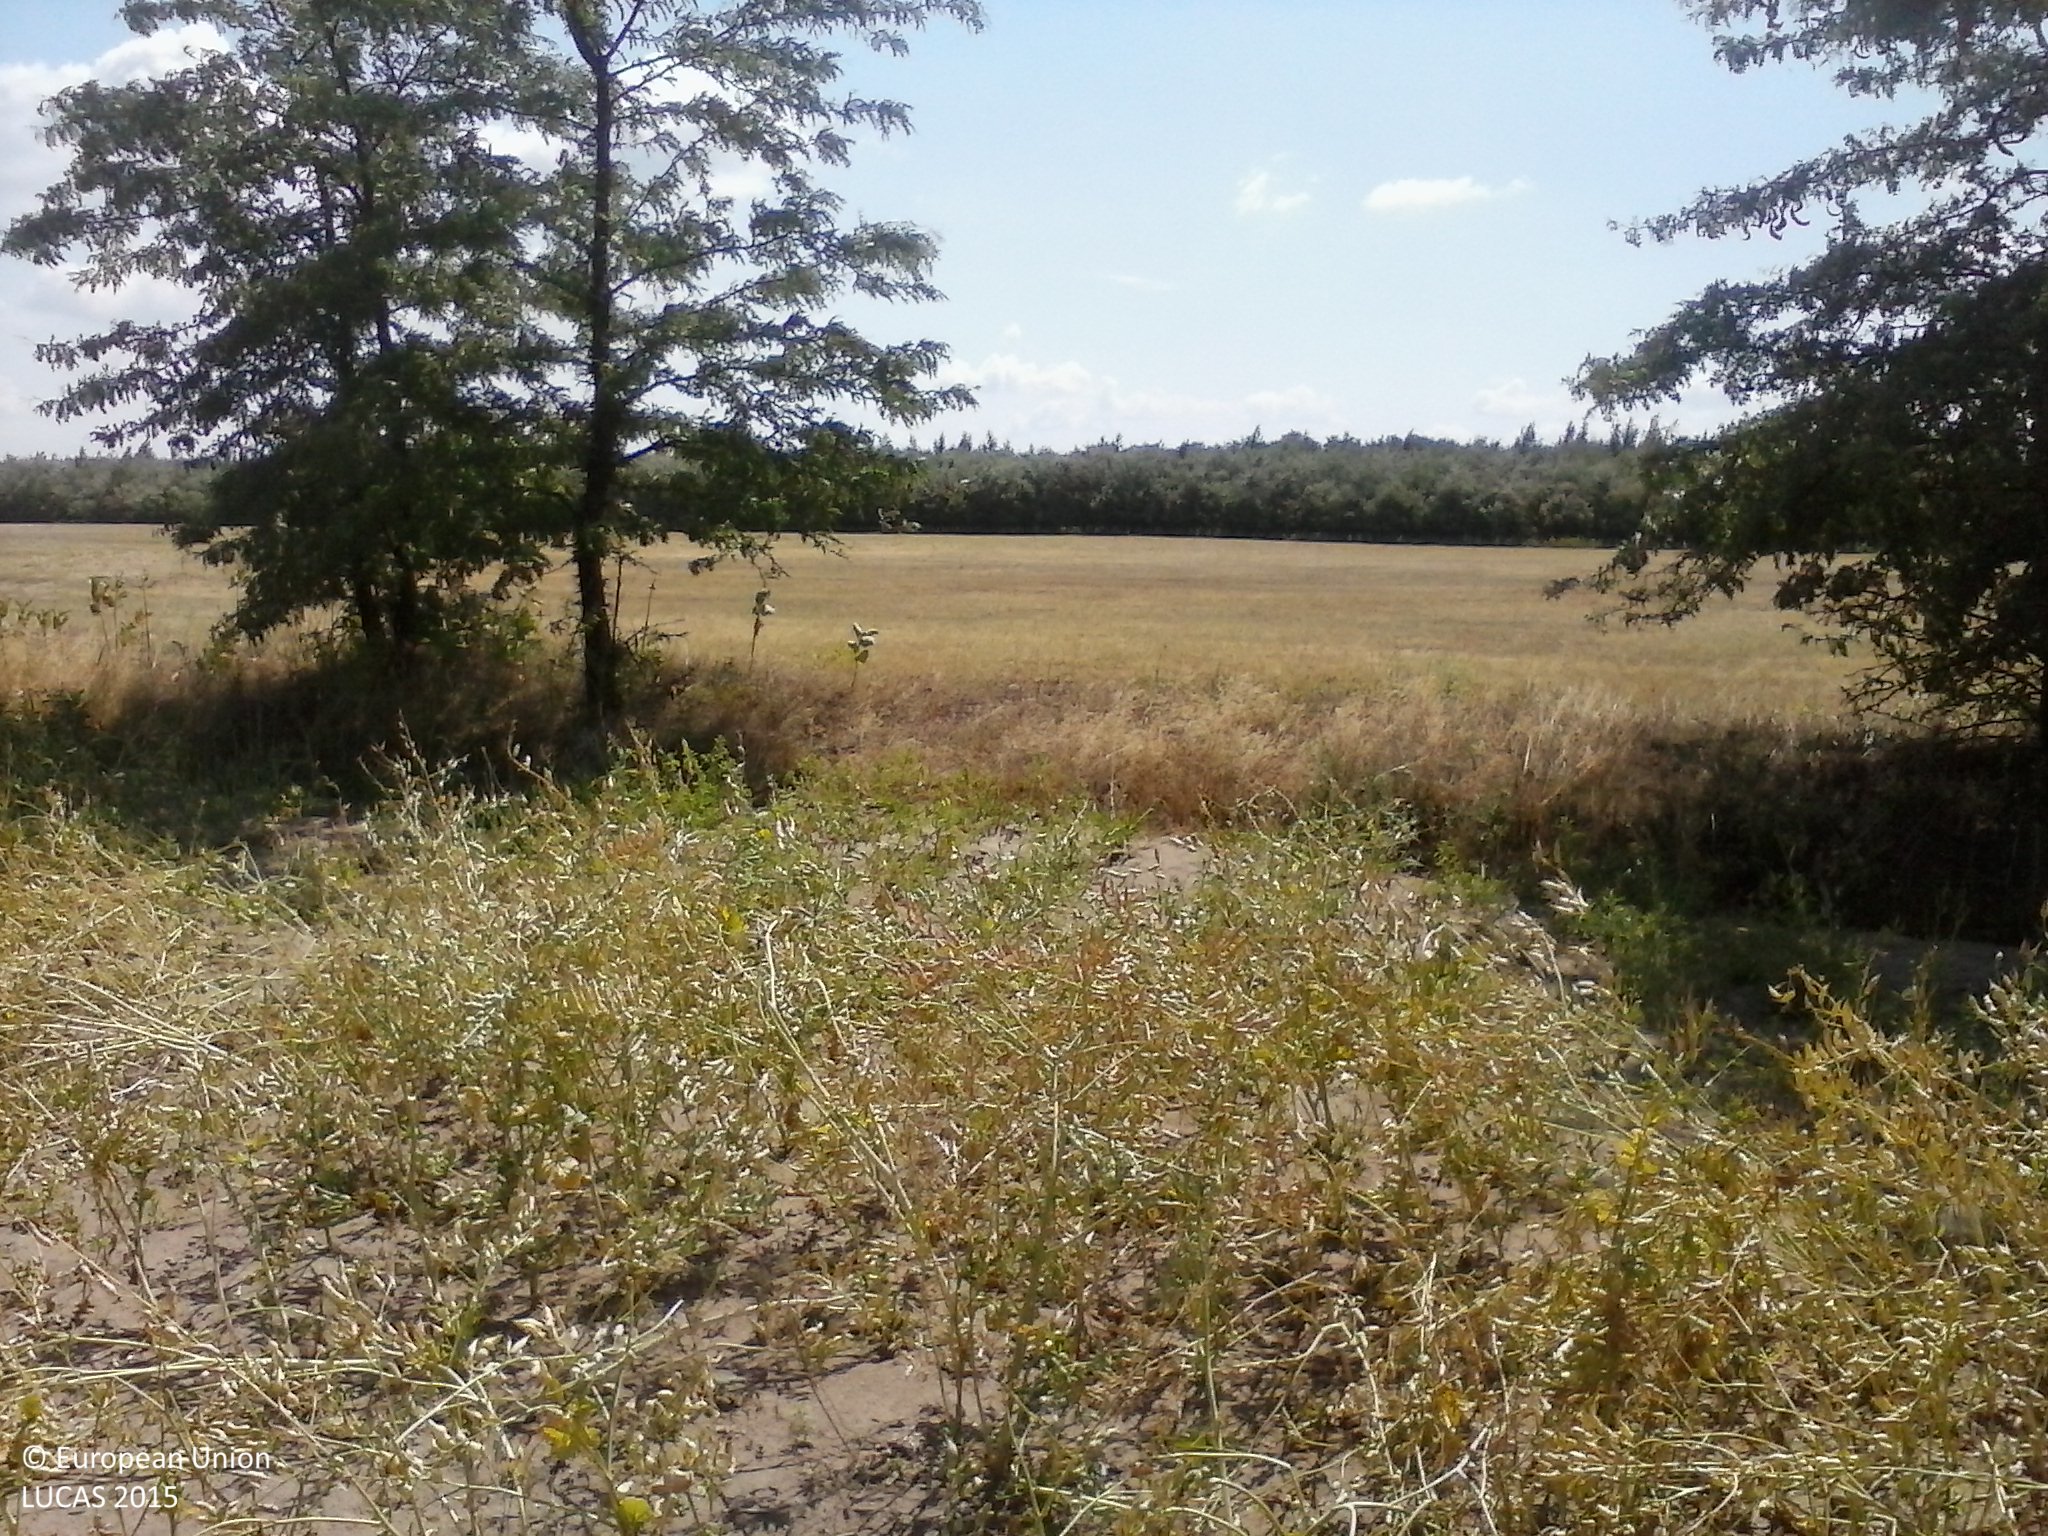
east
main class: Cropland
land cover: Other leguminous and mixtures for fodder
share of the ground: > 75 %
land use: Agriculture (excluding fallow land and kitchen gardens)
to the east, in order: Other leguminous and mixtures for fodder; Single bushes/trees; Grassland without tree/shrub cover; Tracks; Grassland without tree/shrub cover; Broadleaved woodland
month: July
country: HU
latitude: 46.6062
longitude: 19.6147
